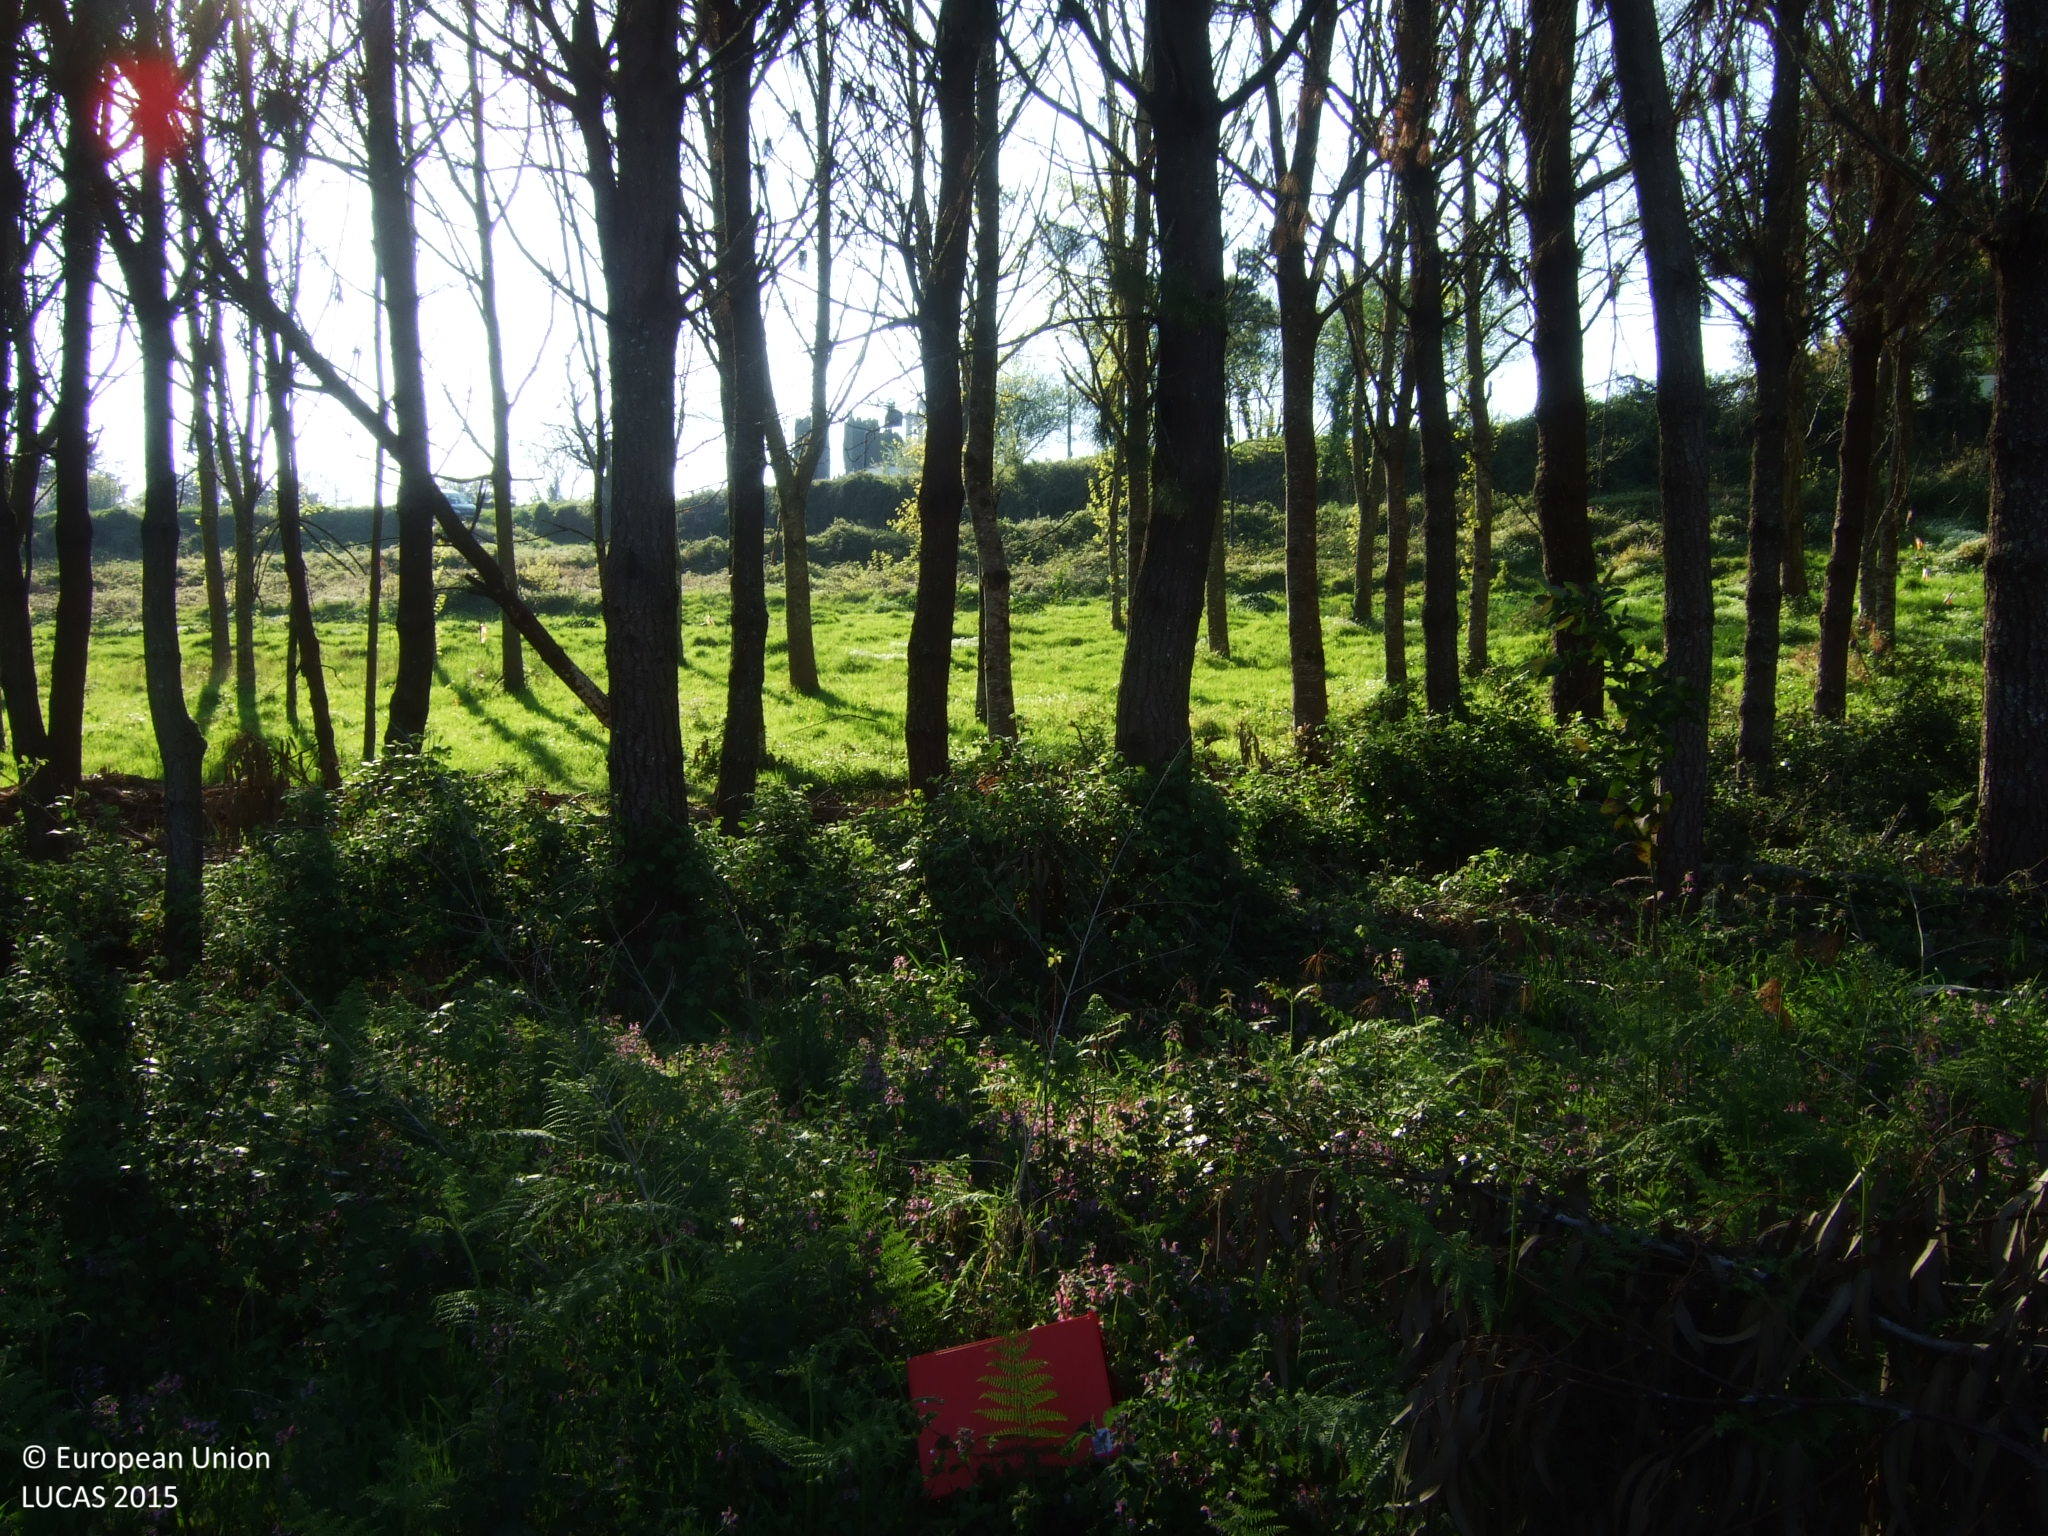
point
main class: Woodland
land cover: Pine dominated coniferous woodland
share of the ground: 25 - 50 %
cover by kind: coniferous forest trees 50 %, herbaceous plants 30 %, shrubs 10 %, consolidated bare surface 10 %
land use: Forestry
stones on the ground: < 10 %
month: April
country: ES
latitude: 43.0838
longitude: -7.6333
